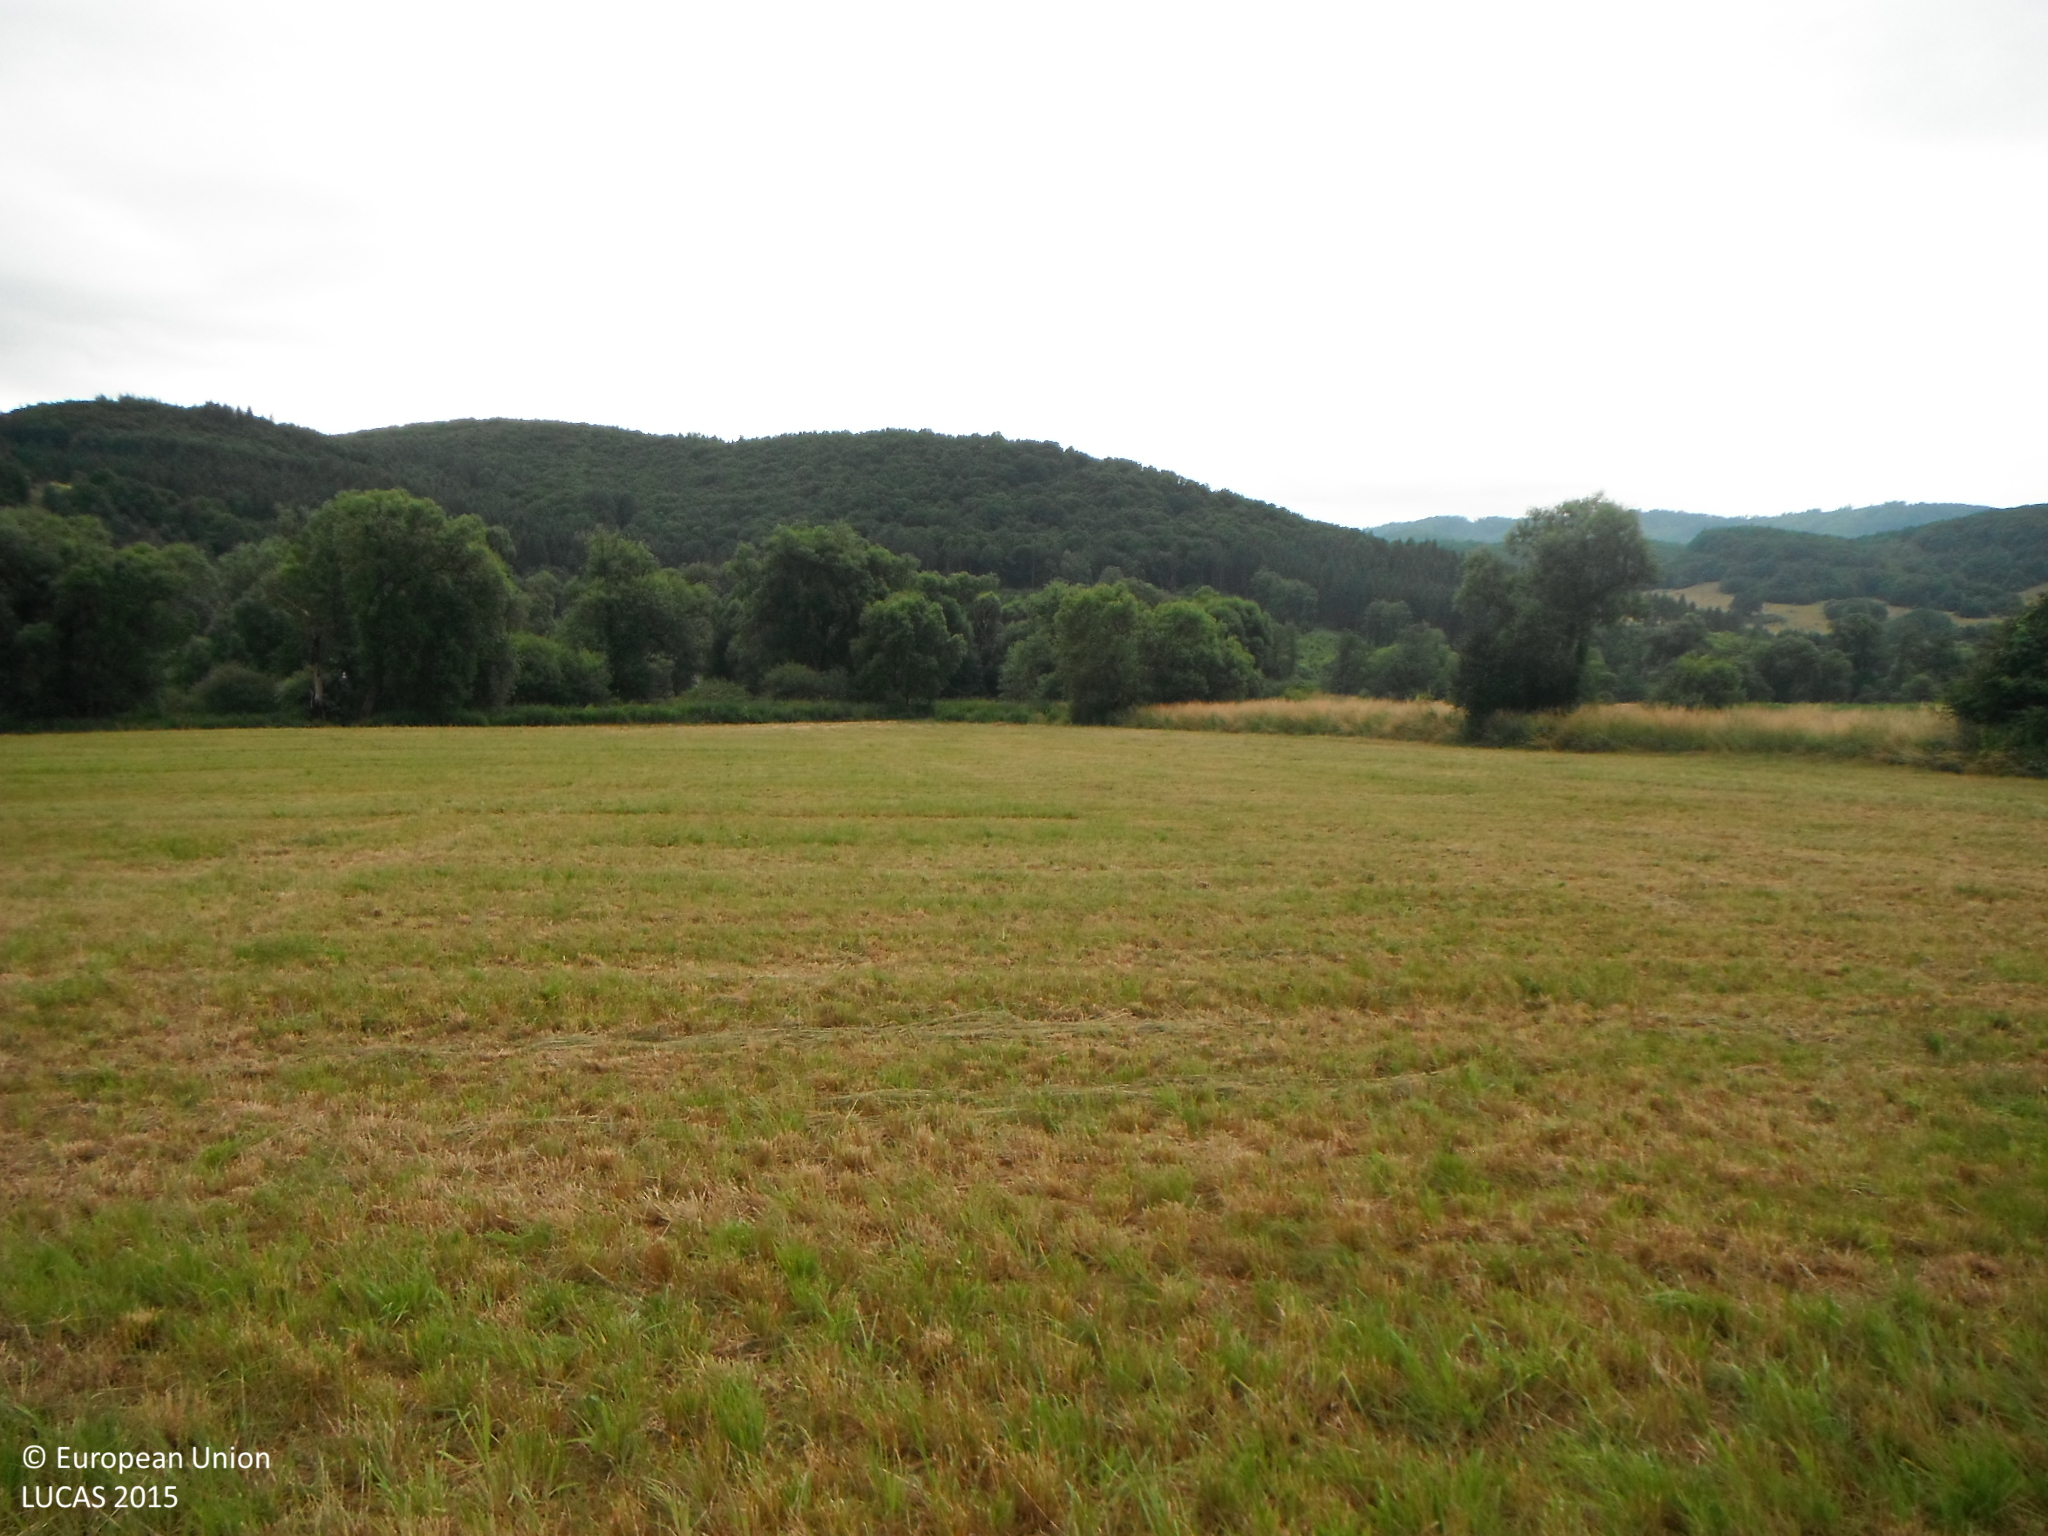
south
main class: Grassland
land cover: Grassland without tree/shrub cover
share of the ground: > 75 %
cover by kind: herbaceous plants 100 %
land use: Agriculture (excluding fallow land and kitchen gardens)
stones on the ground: < 10 %
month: June
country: SK
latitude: 48.5583
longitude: 19.2498
